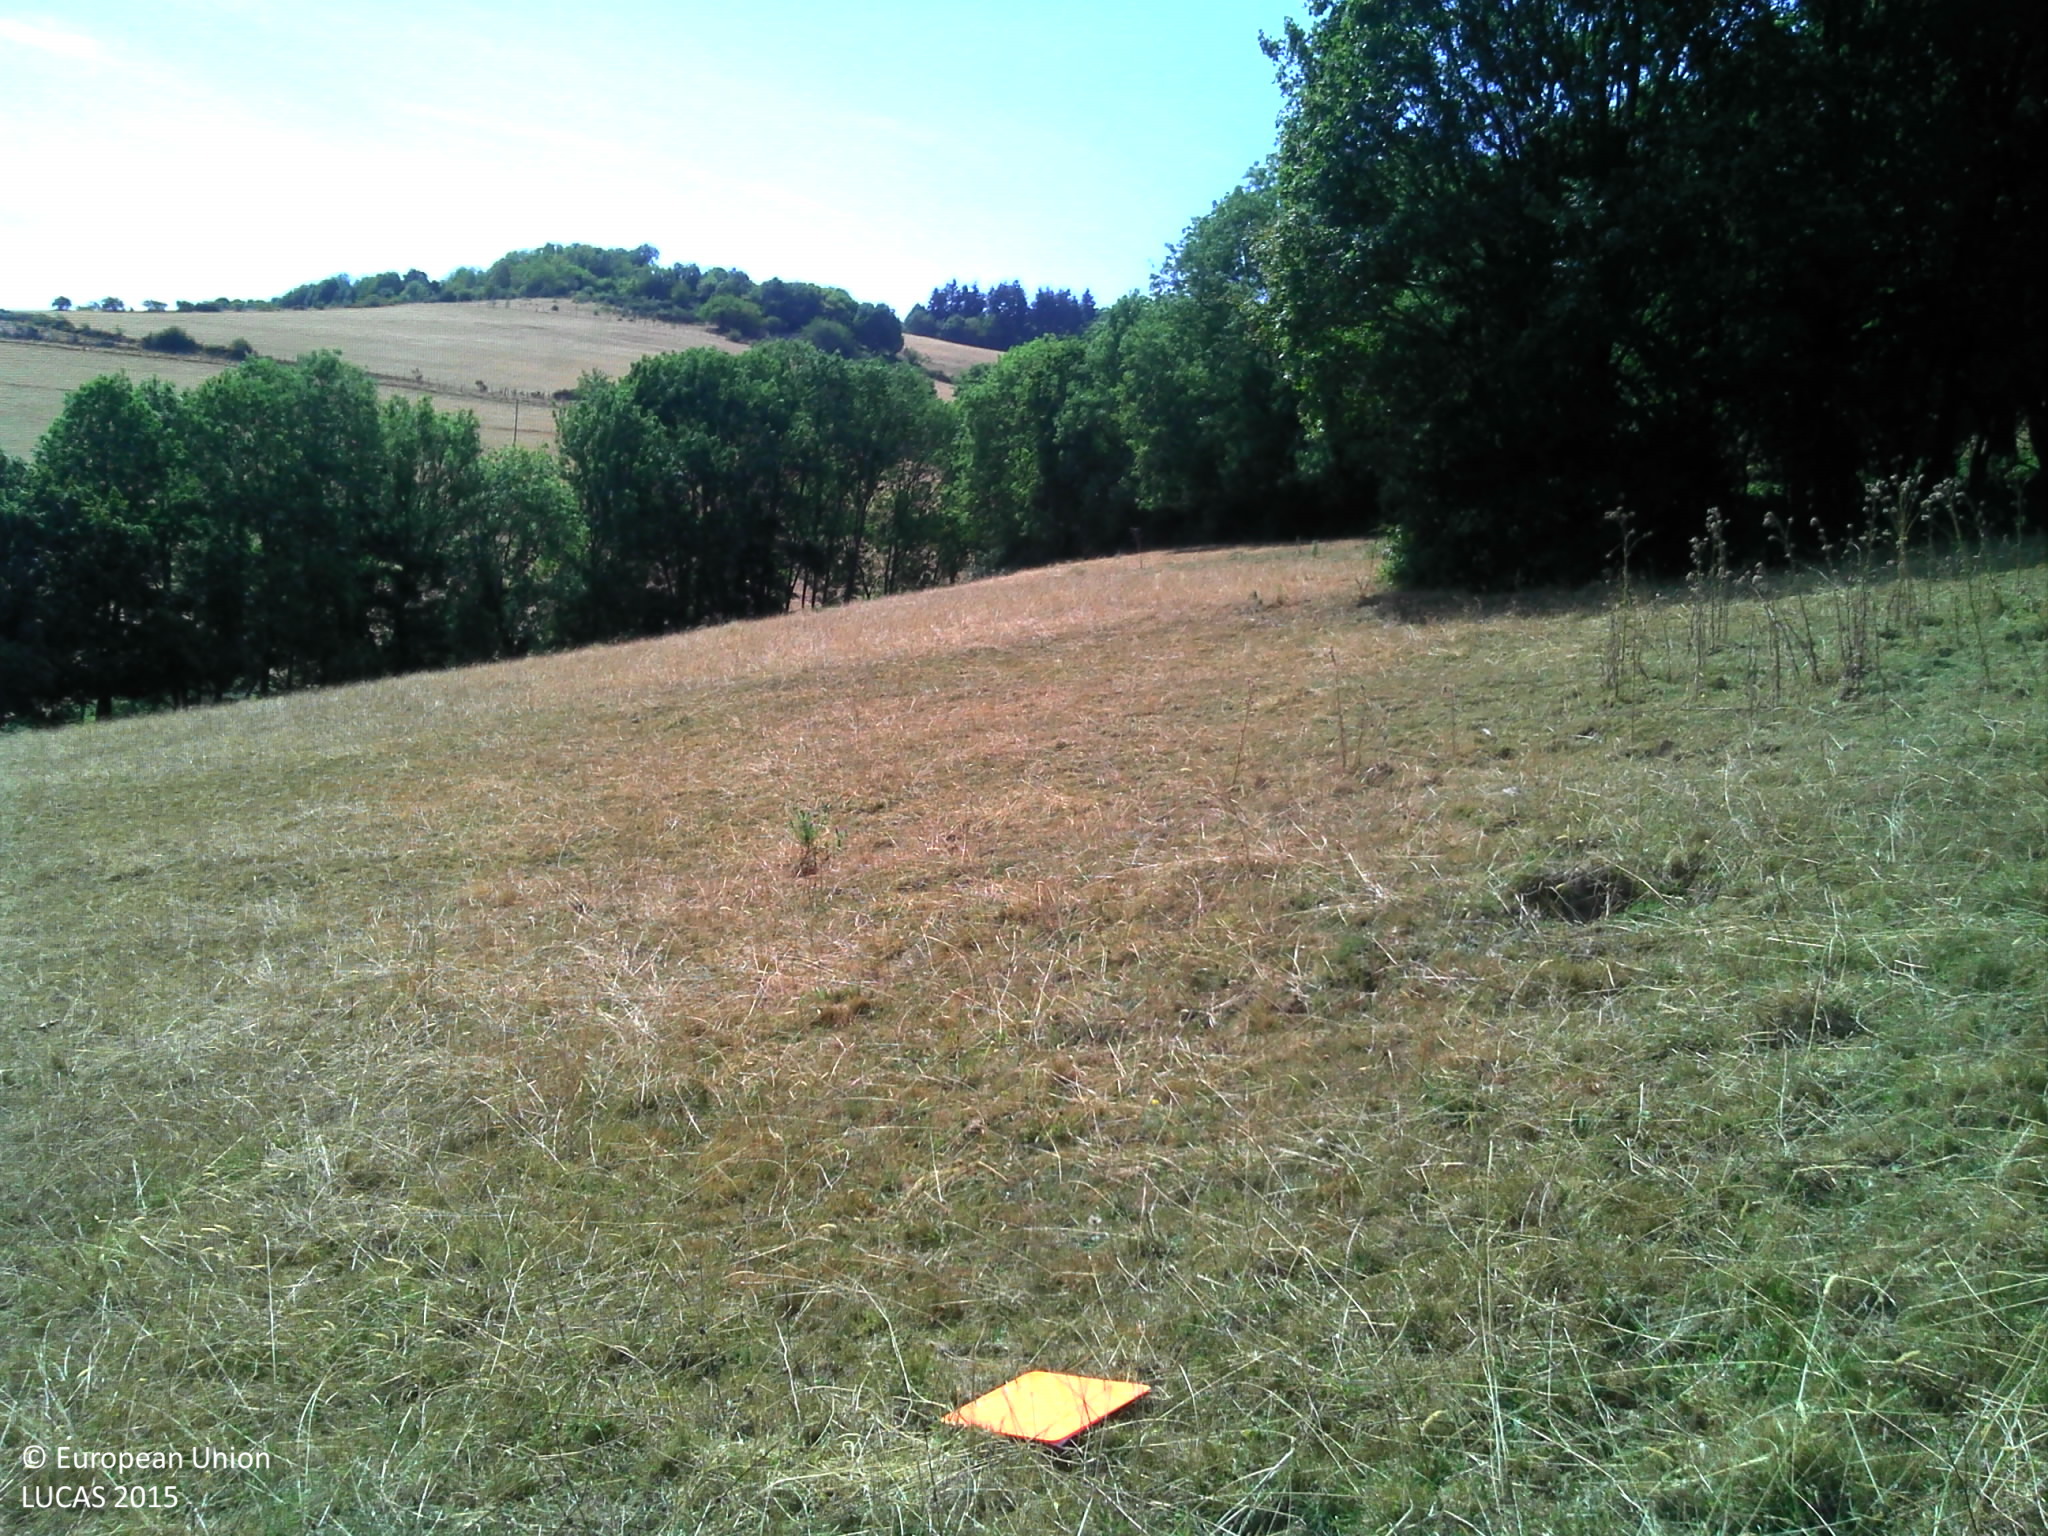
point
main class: Grassland
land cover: Grassland with sparse tree/shrub cover
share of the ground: > 75 %
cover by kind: herbaceous plants 90 %, broadleaved forest trees 5 %, shrubs 5 %
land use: Agriculture (excluding fallow land and kitchen gardens)
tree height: < 5 m
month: July
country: FR
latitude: 45.9180
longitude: 4.4456
